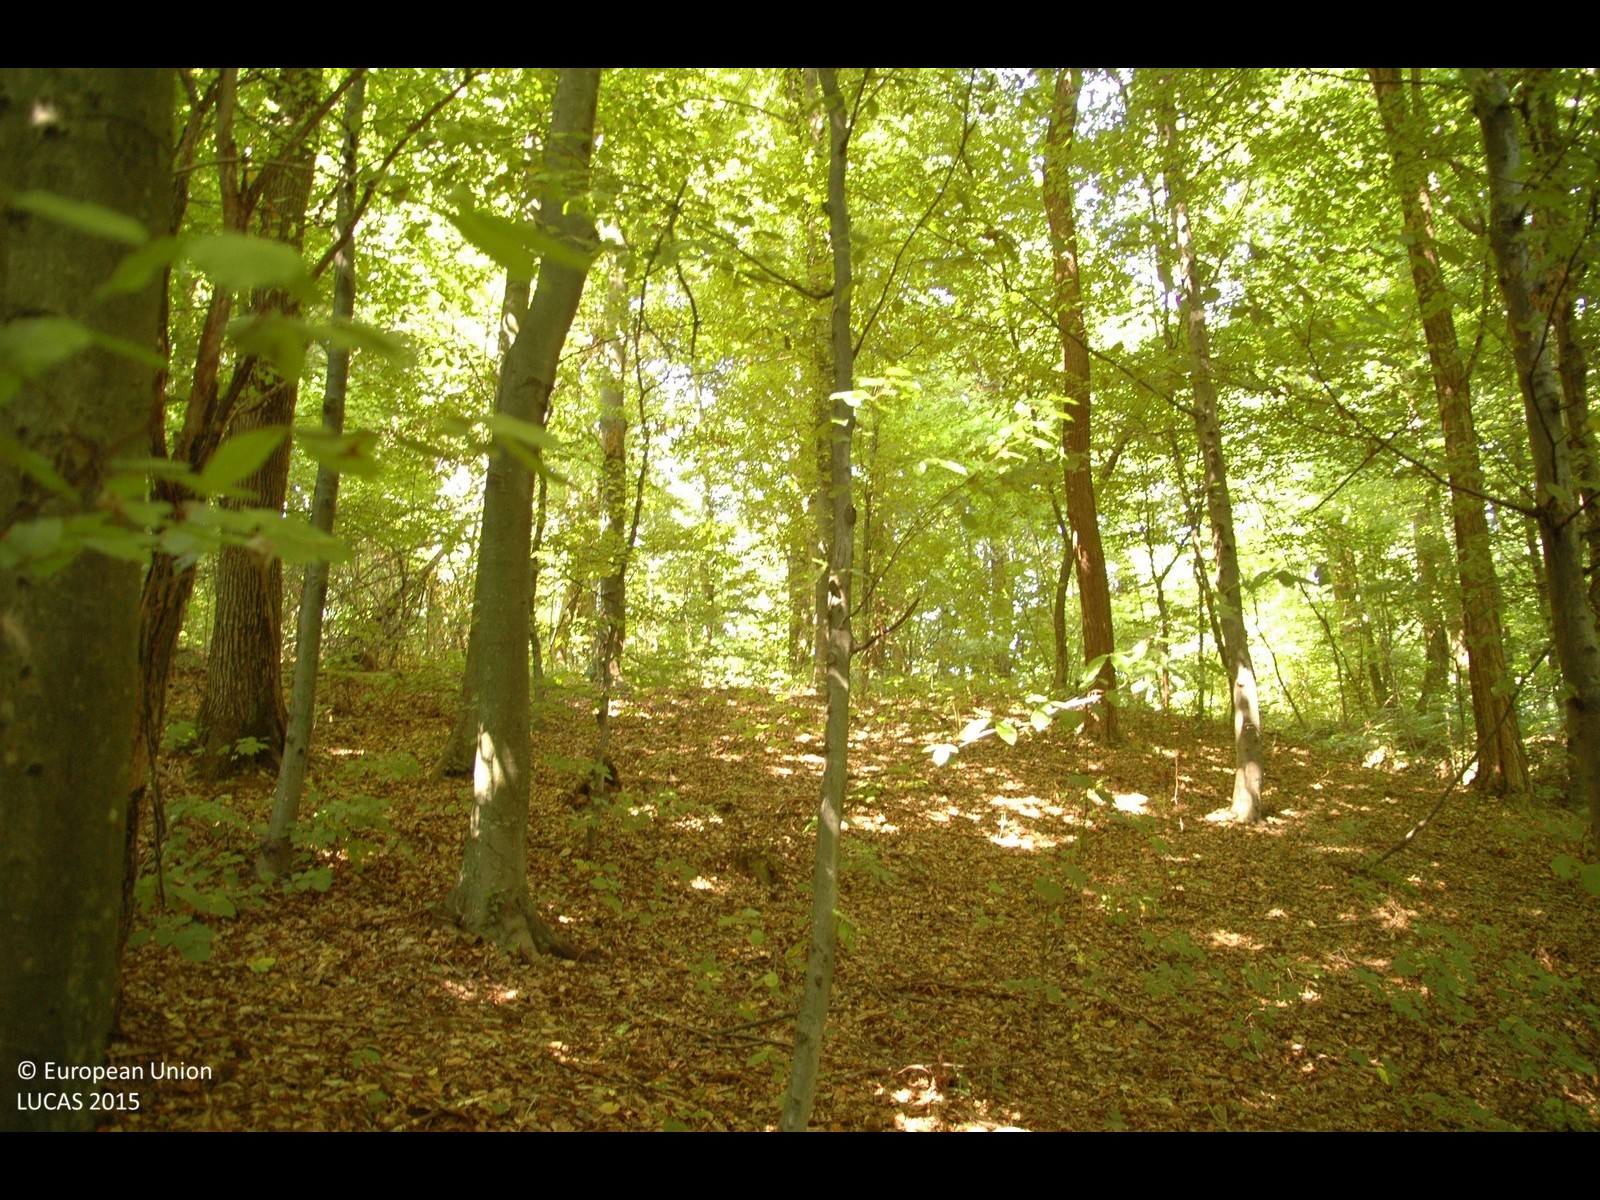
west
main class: Woodland
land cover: Broadleaved woodland
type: beech forest
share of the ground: > 75 %
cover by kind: broadleaved forest trees 100 %
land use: Forestry
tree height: > 5 m
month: August
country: HR
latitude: 46.1757
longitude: 16.7238
